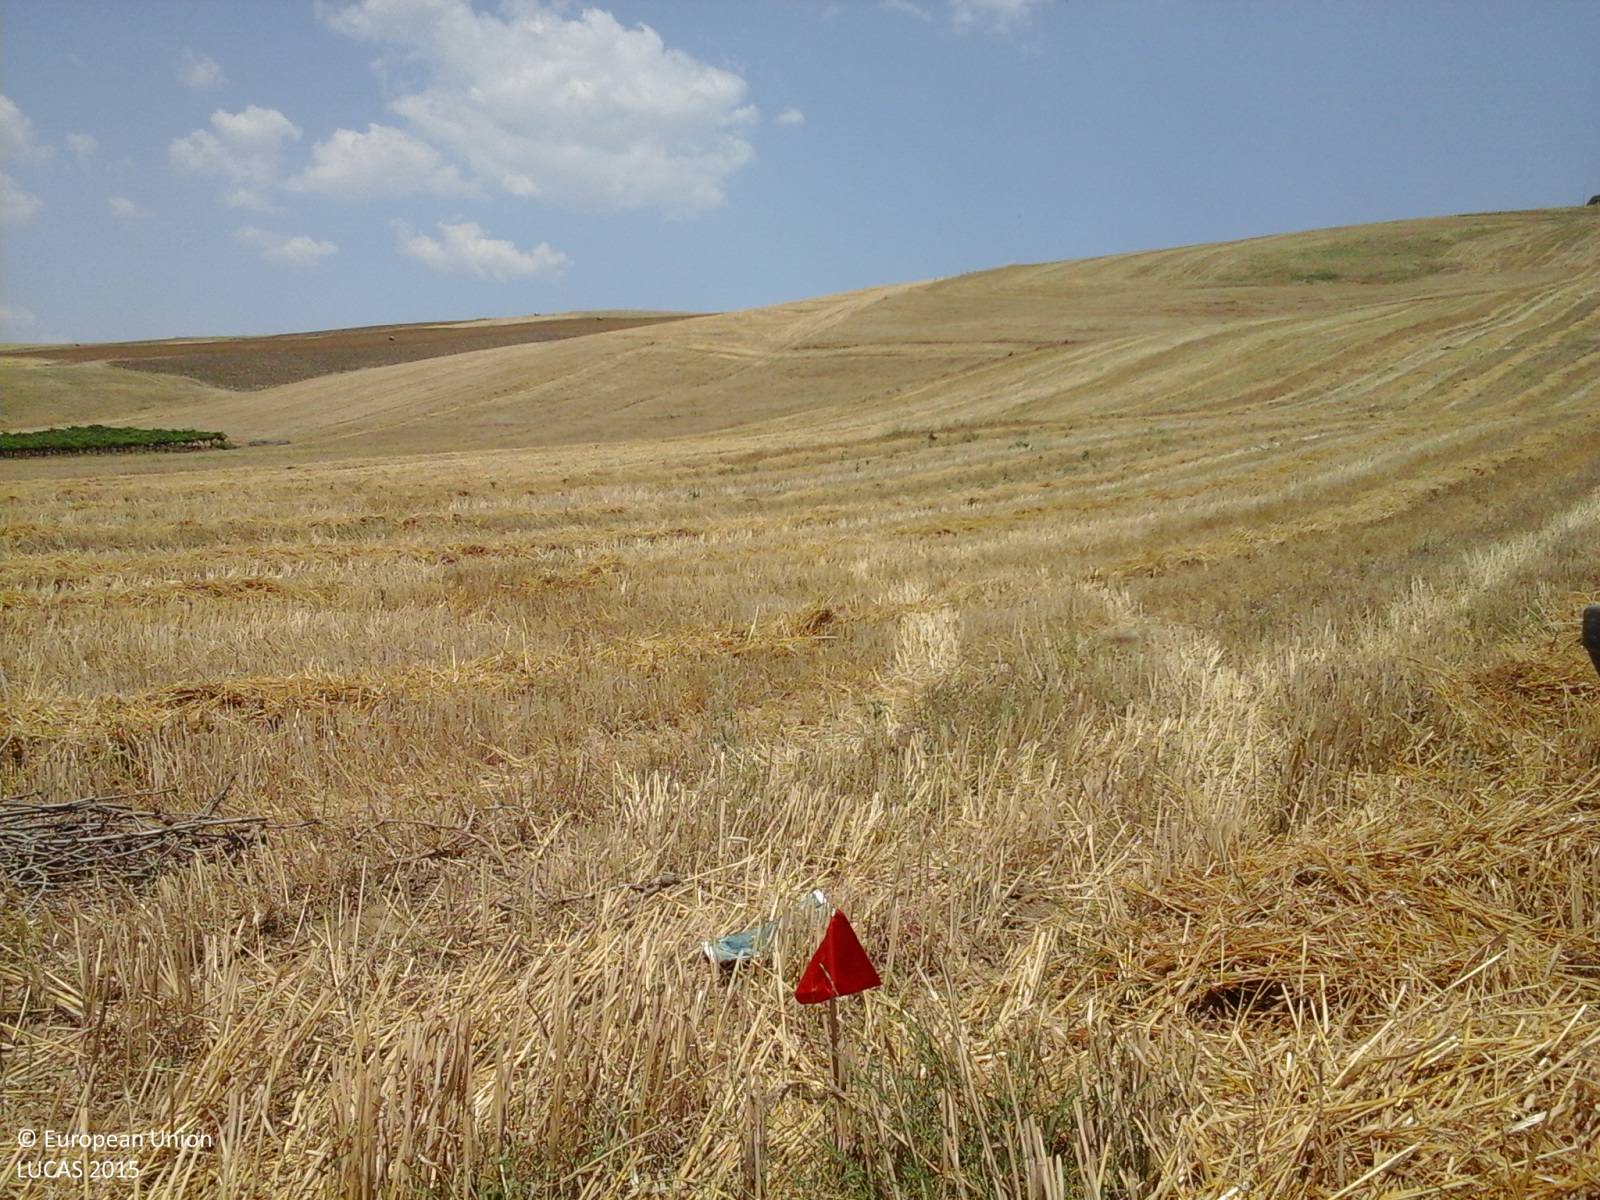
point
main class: Cropland
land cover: Durum wheat
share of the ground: > 75 %
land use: Agriculture (excluding fallow land and kitchen gardens)
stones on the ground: < 10 %
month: July
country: IT
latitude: 37.8015
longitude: 13.2358
